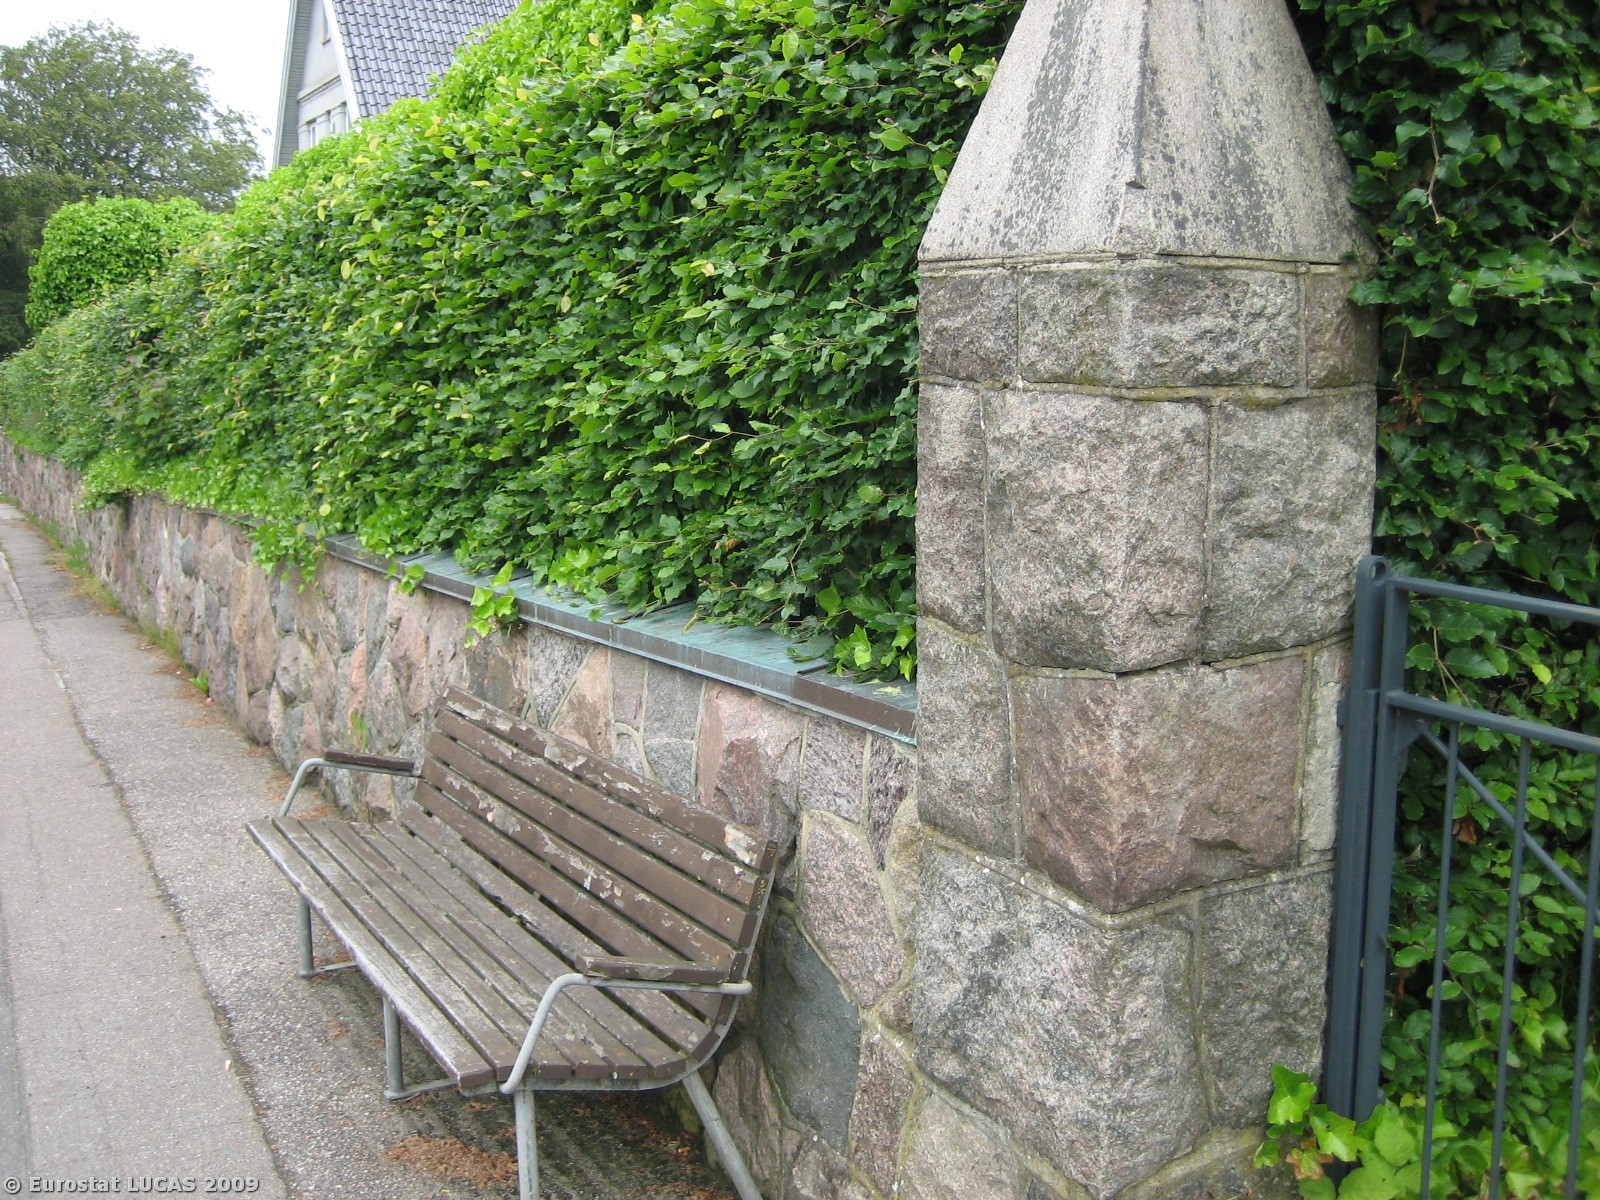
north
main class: Grassland
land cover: Grassland without tree/shrub cover
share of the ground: > 75 %
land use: Residential
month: June
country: DK
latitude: 56.1336
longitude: 10.2089
